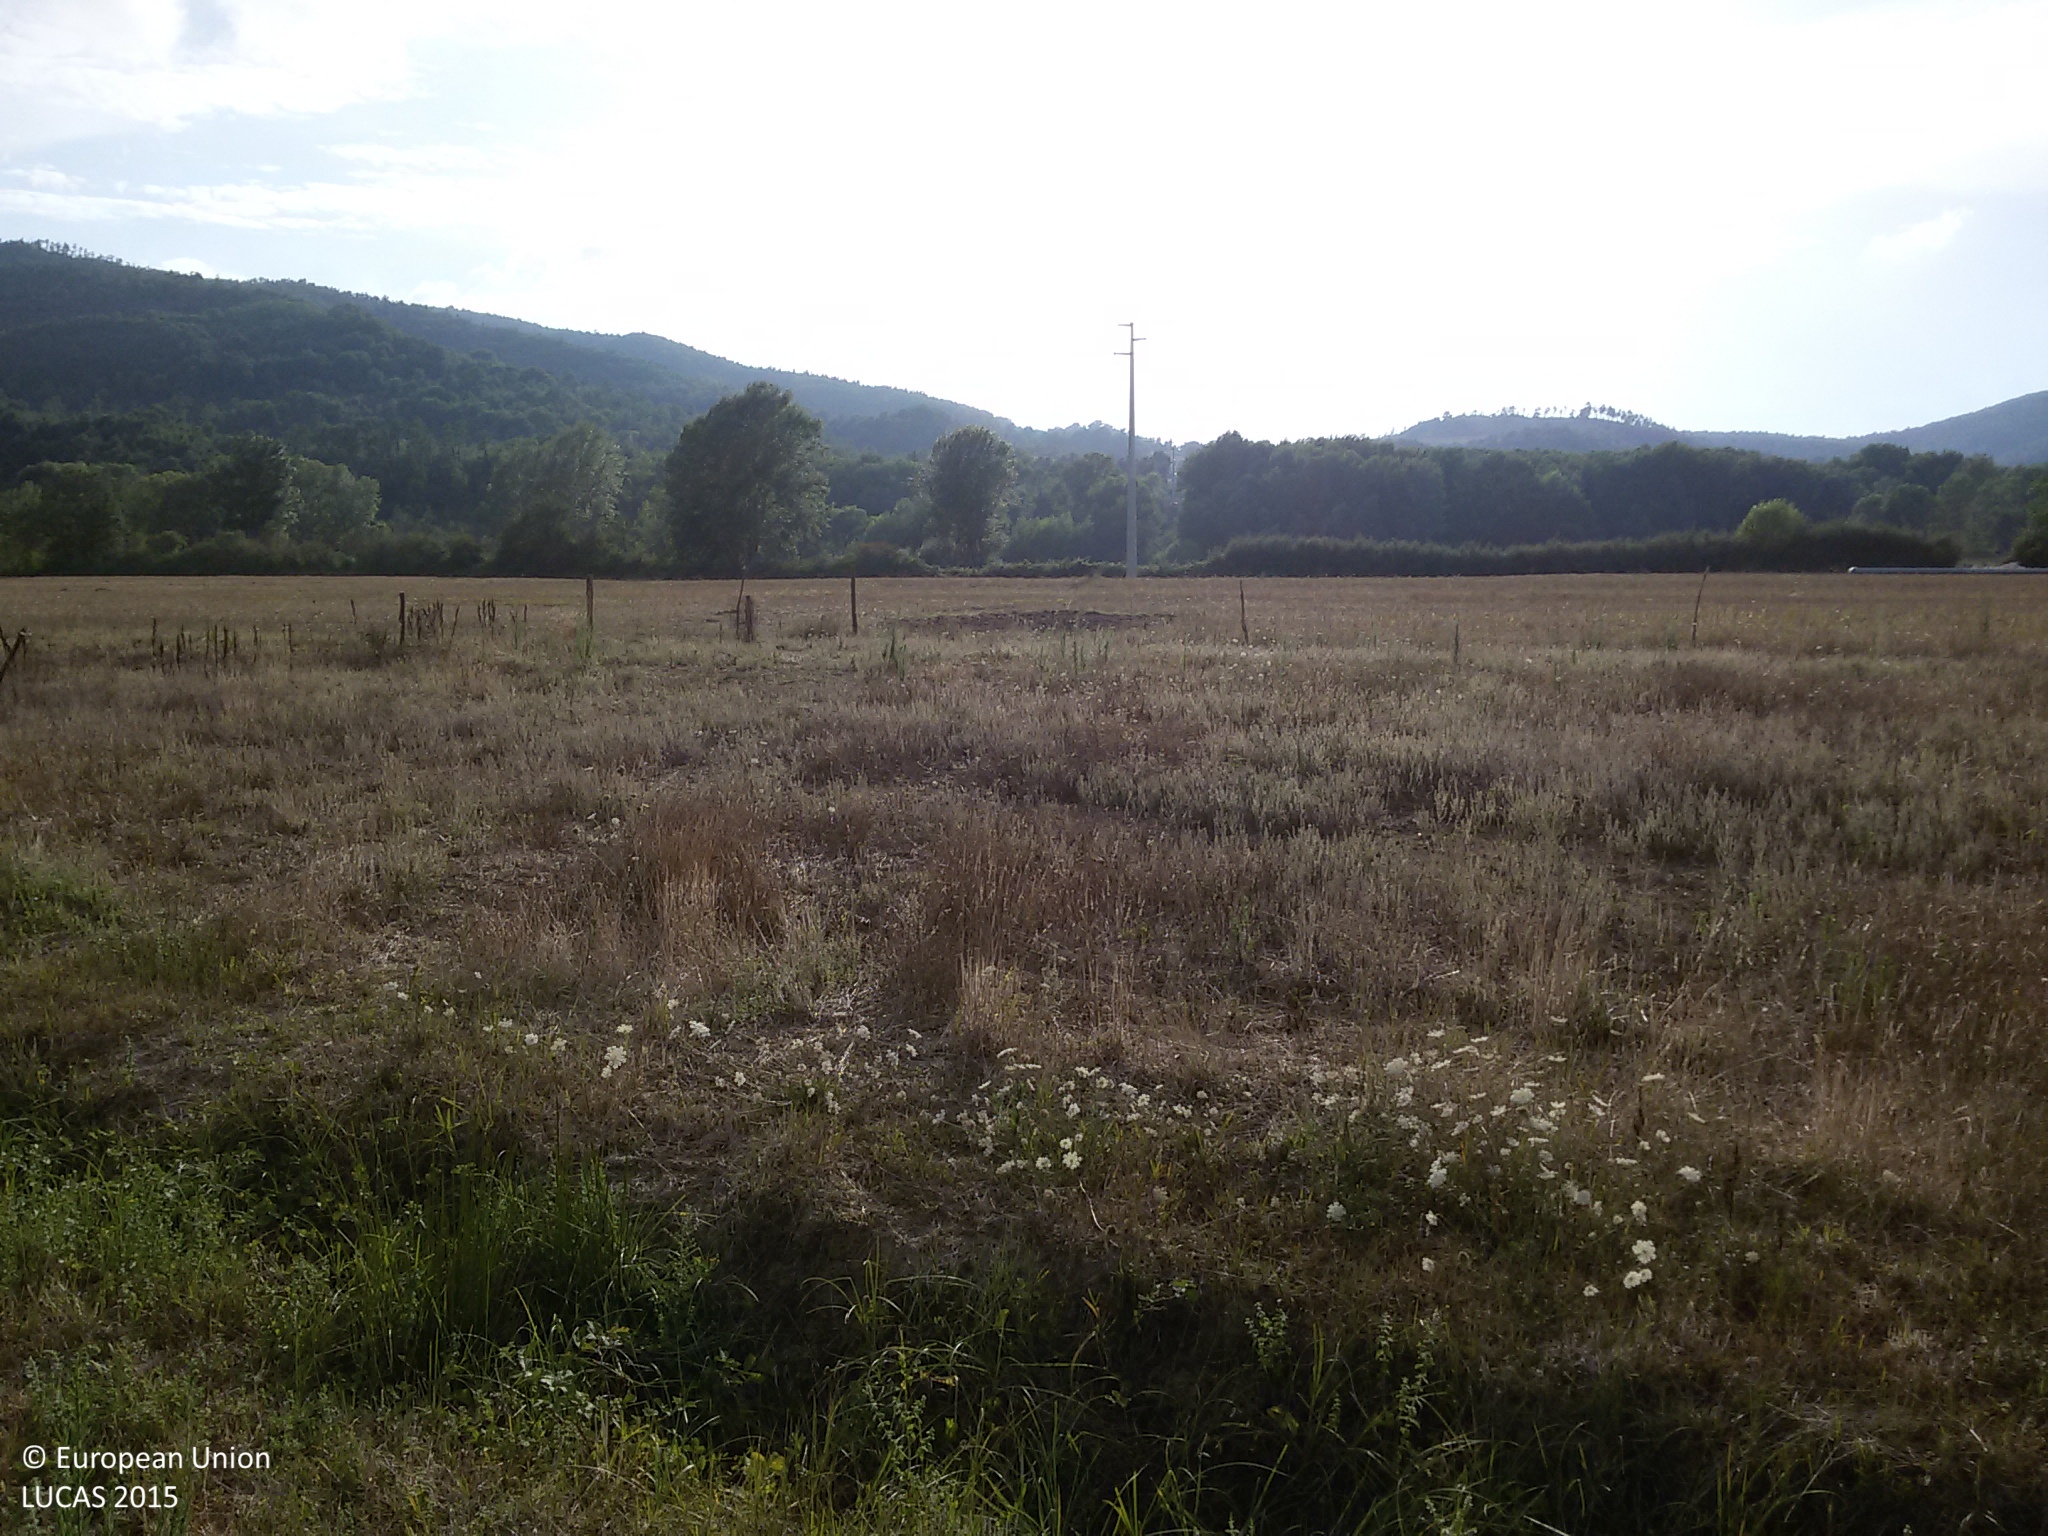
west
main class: Grassland
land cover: Grassland without tree/shrub cover
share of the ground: > 75 %
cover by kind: herbaceous plants 95 %, unconsolidated bare surface 5 %
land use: Agriculture (excluding fallow land and kitchen gardens)
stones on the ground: < 10 %
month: August
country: IT
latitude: 42.6054
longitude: 11.5914
